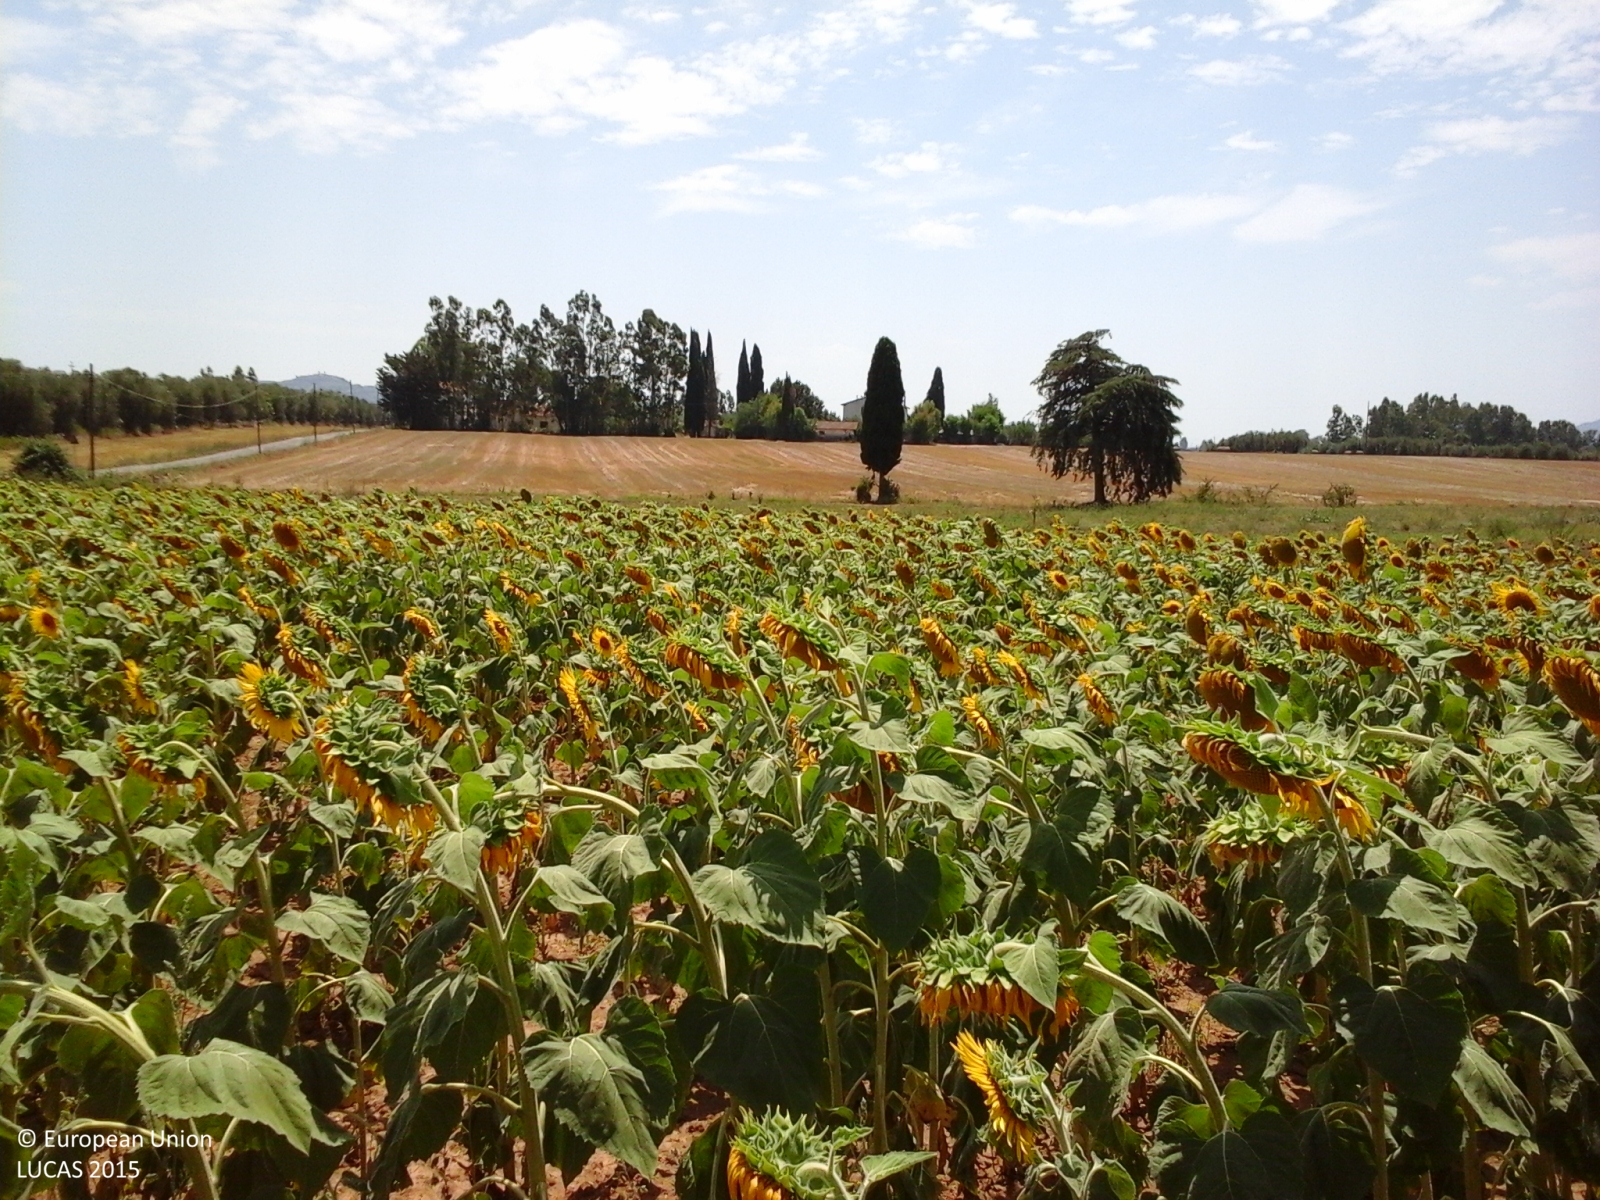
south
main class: Cropland
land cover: Sunflower
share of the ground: > 75 %
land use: Agriculture (excluding fallow land and kitchen gardens)
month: July
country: IT
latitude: 42.9374
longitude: 11.0628
